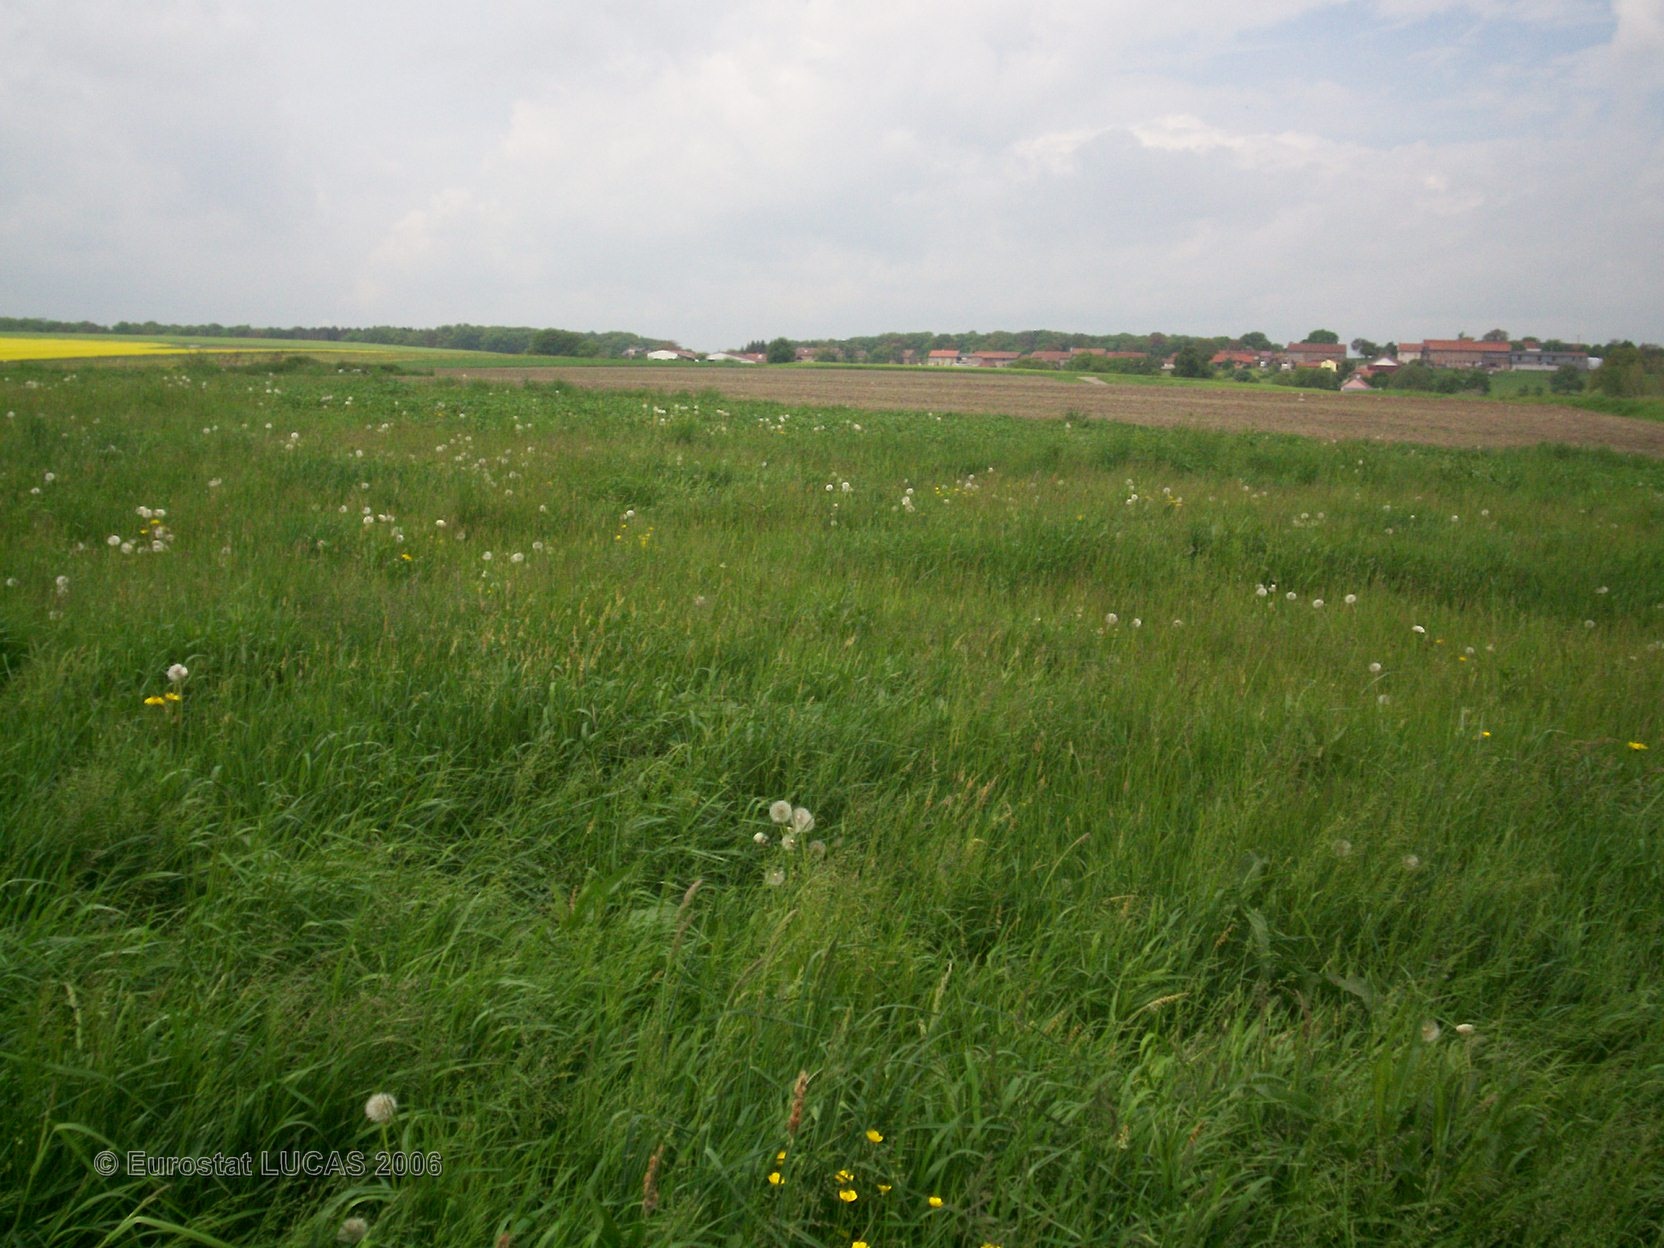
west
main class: Grassland
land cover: Grassland without tree/shrub cover
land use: Agriculture (excluding fallow land and kitchen gardens)
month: May
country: FR
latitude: 49.3536
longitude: 6.4067
